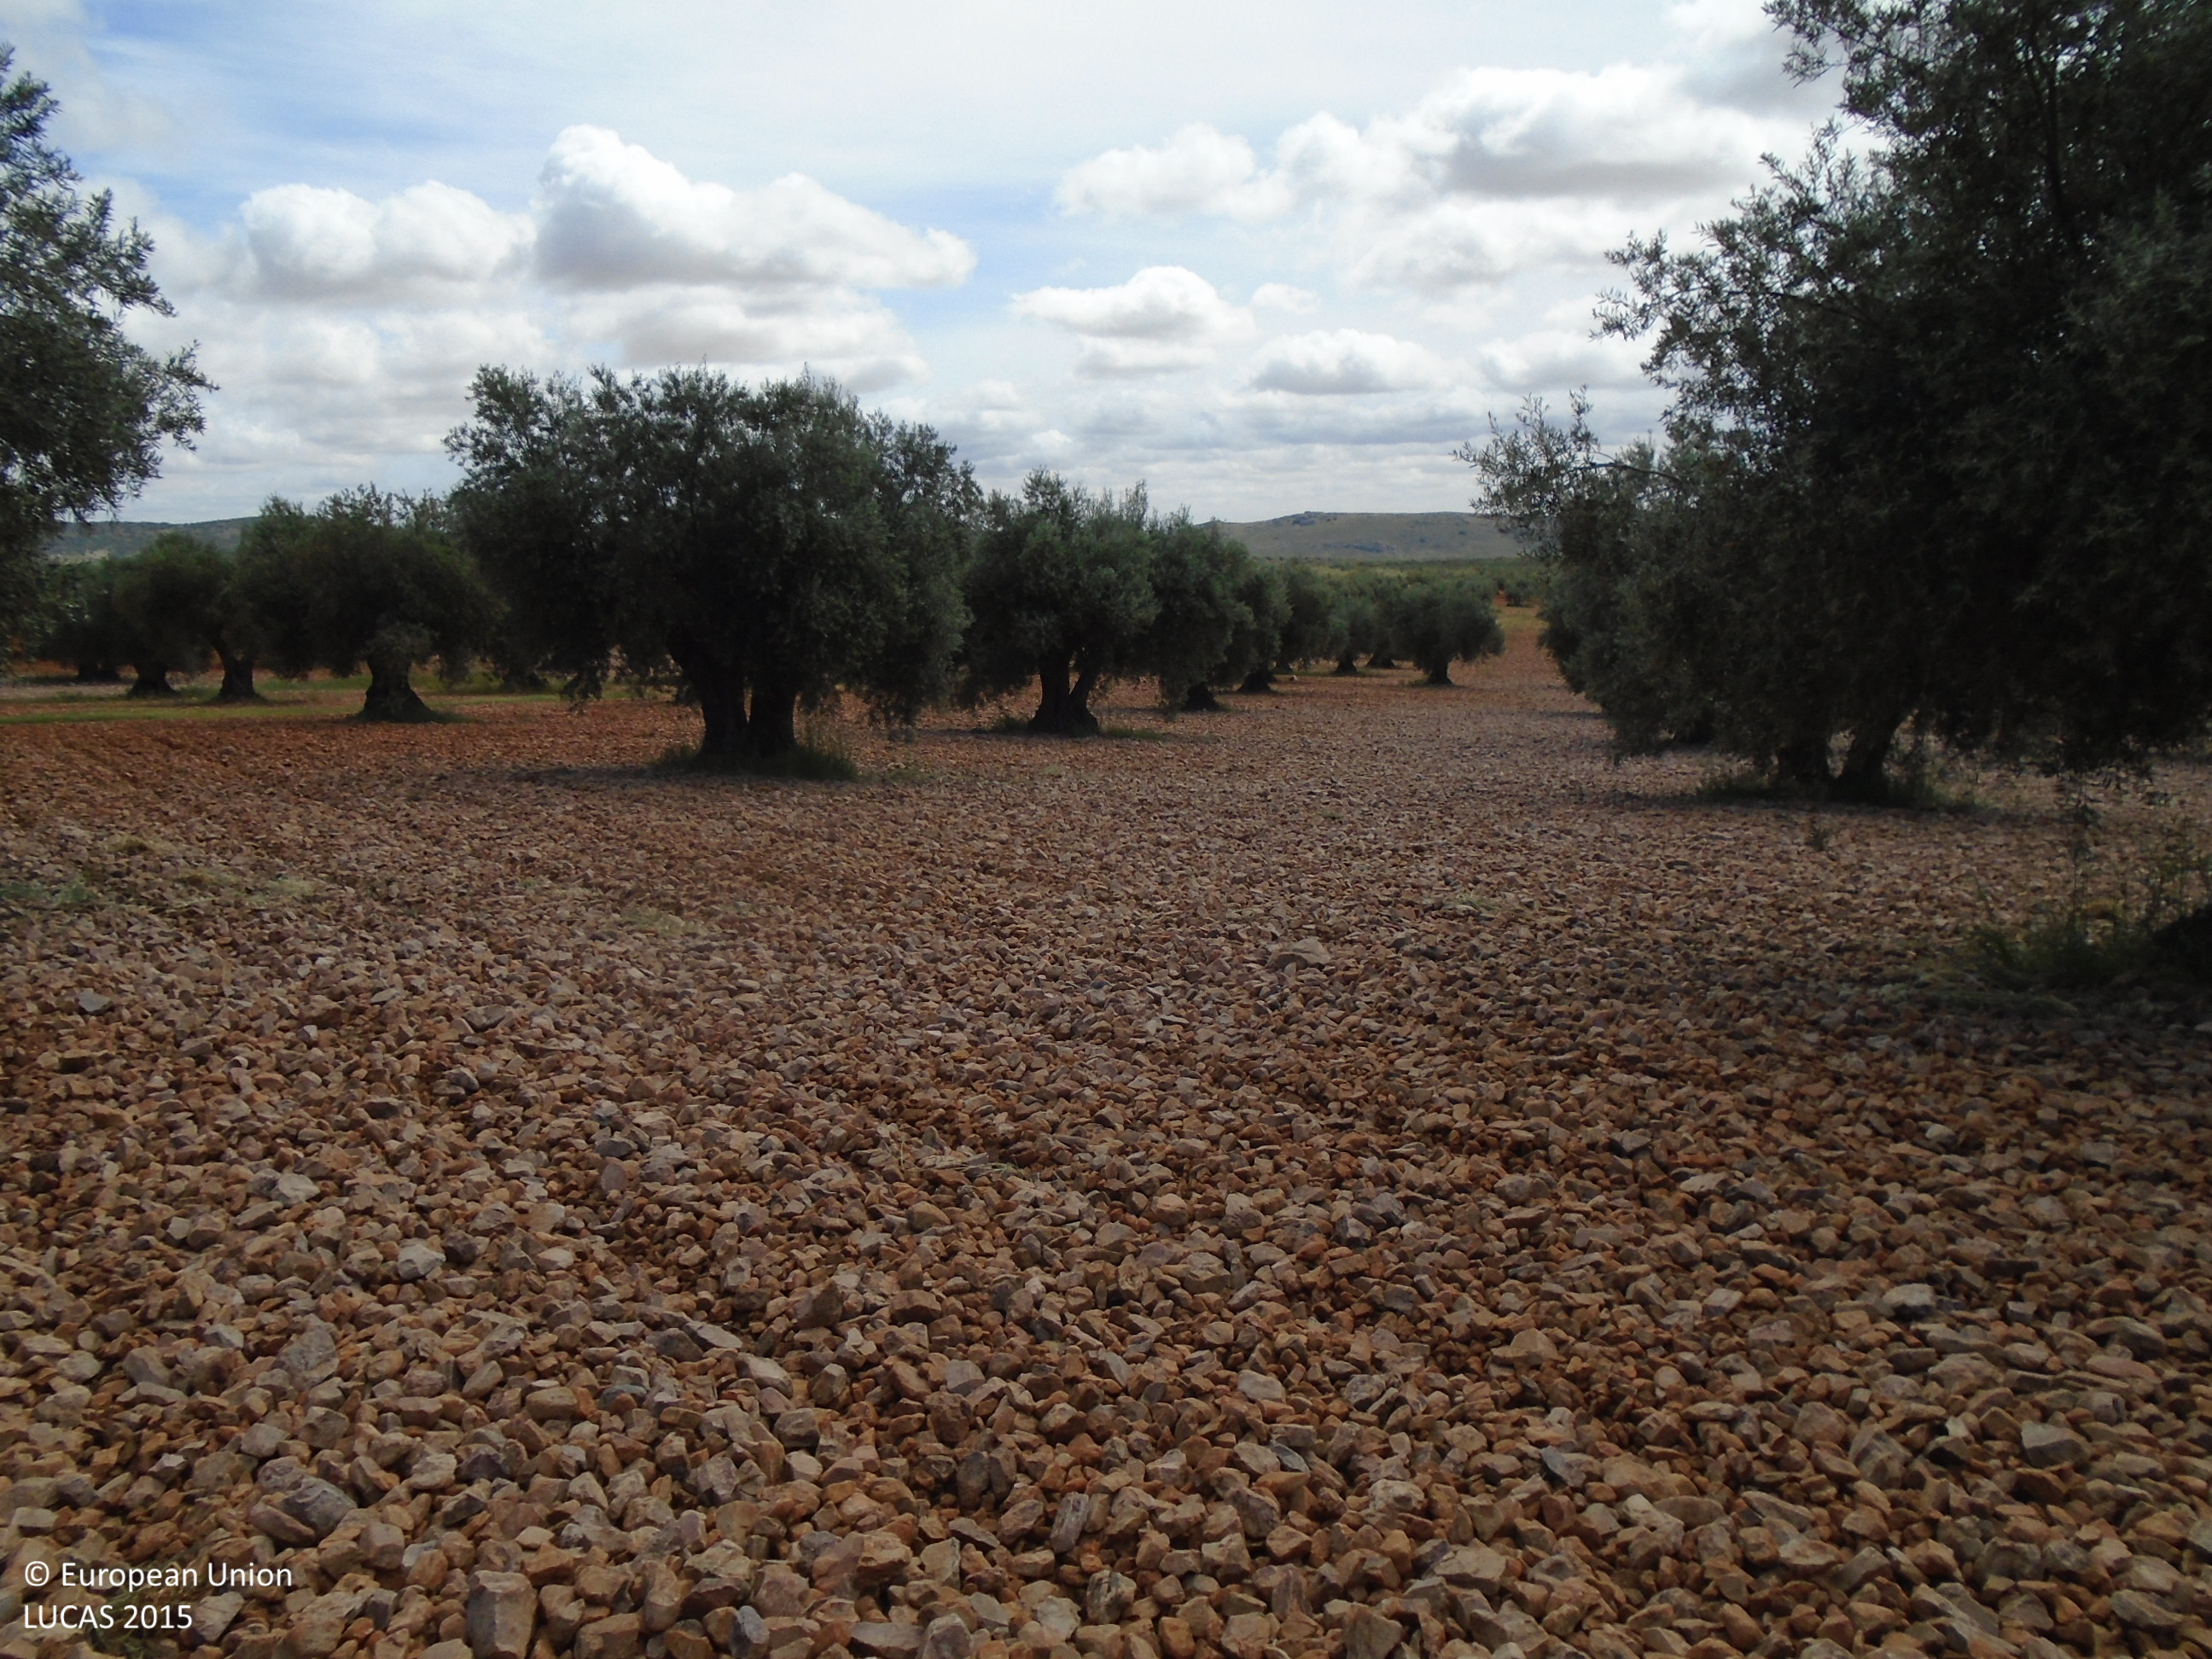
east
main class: Cropland
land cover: Olive groves
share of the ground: 10 - 25 %
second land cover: Other bare soil
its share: > 75 %
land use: Agriculture (excluding fallow land and kitchen gardens)
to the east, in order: Olive groves; Other bare soil; Tracks; Olive groves
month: May
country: ES
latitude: 39.6498
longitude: -3.6973
